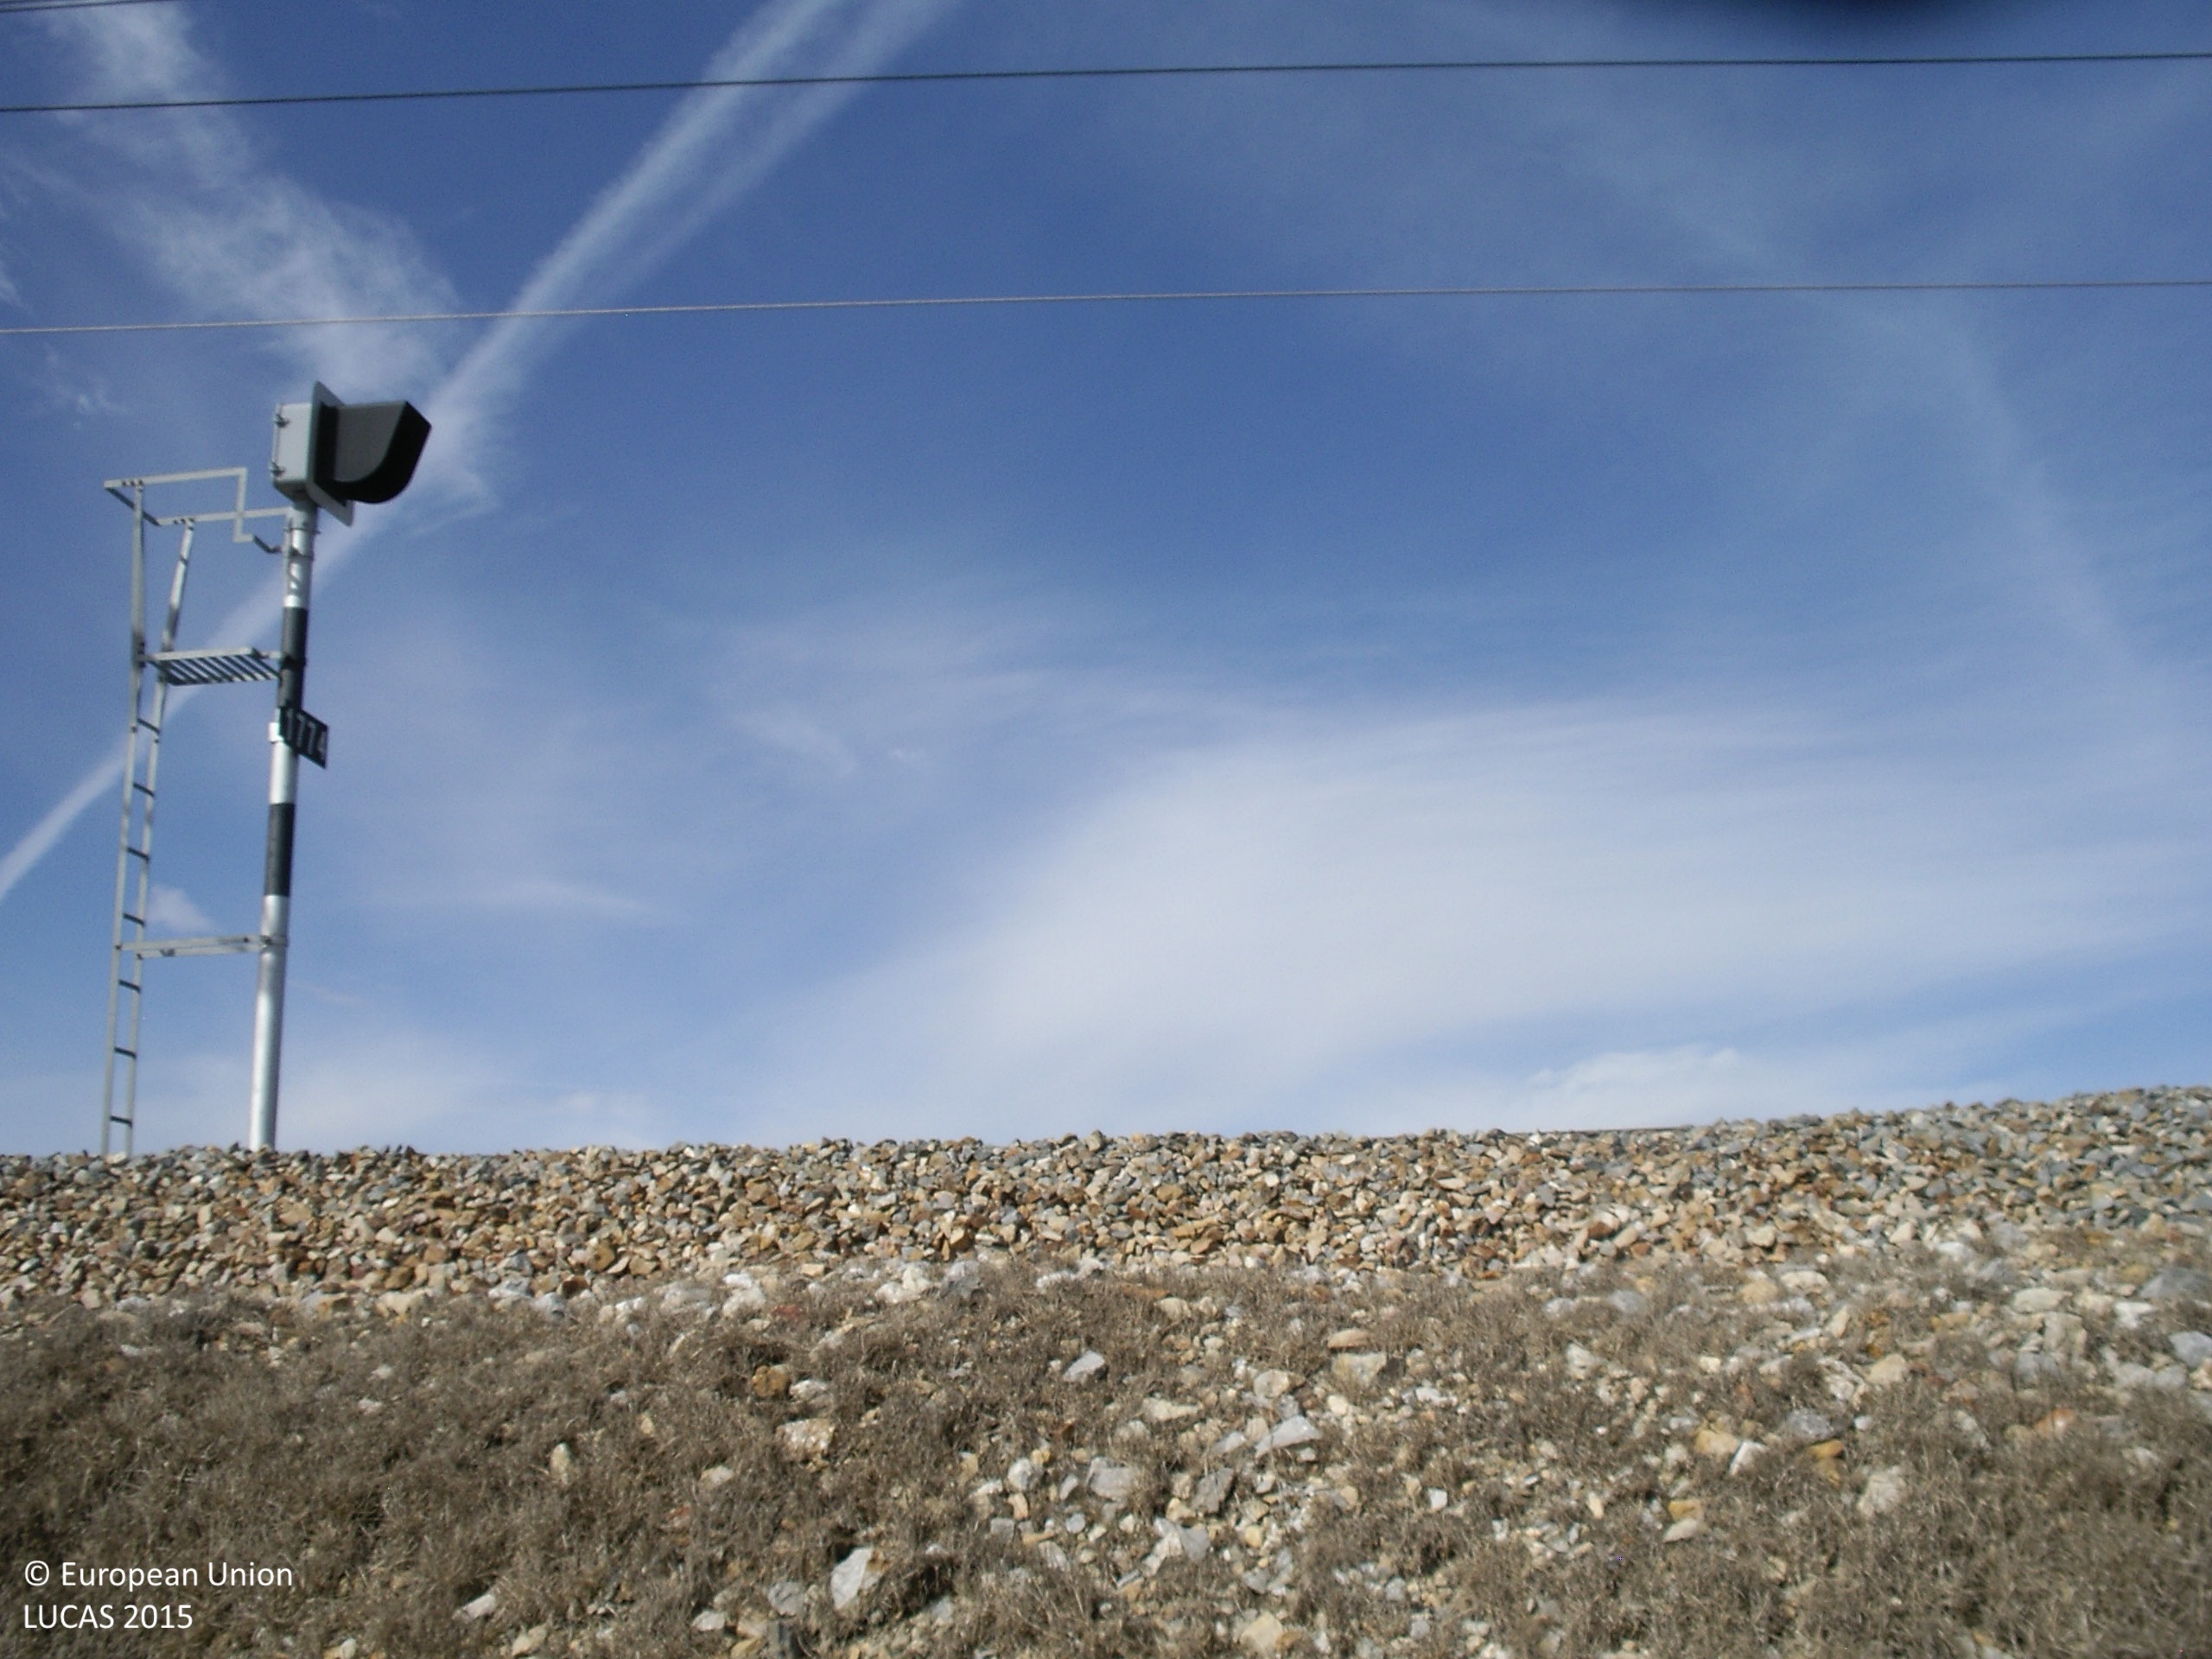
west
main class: Grassland
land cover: Grassland without tree/shrub cover
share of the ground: 10 - 25 %
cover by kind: herbaceous plants 50 %, unconsolidated bare surface 20 %
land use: Railway transport
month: April
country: ES
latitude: 42.4844
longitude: -6.0552
